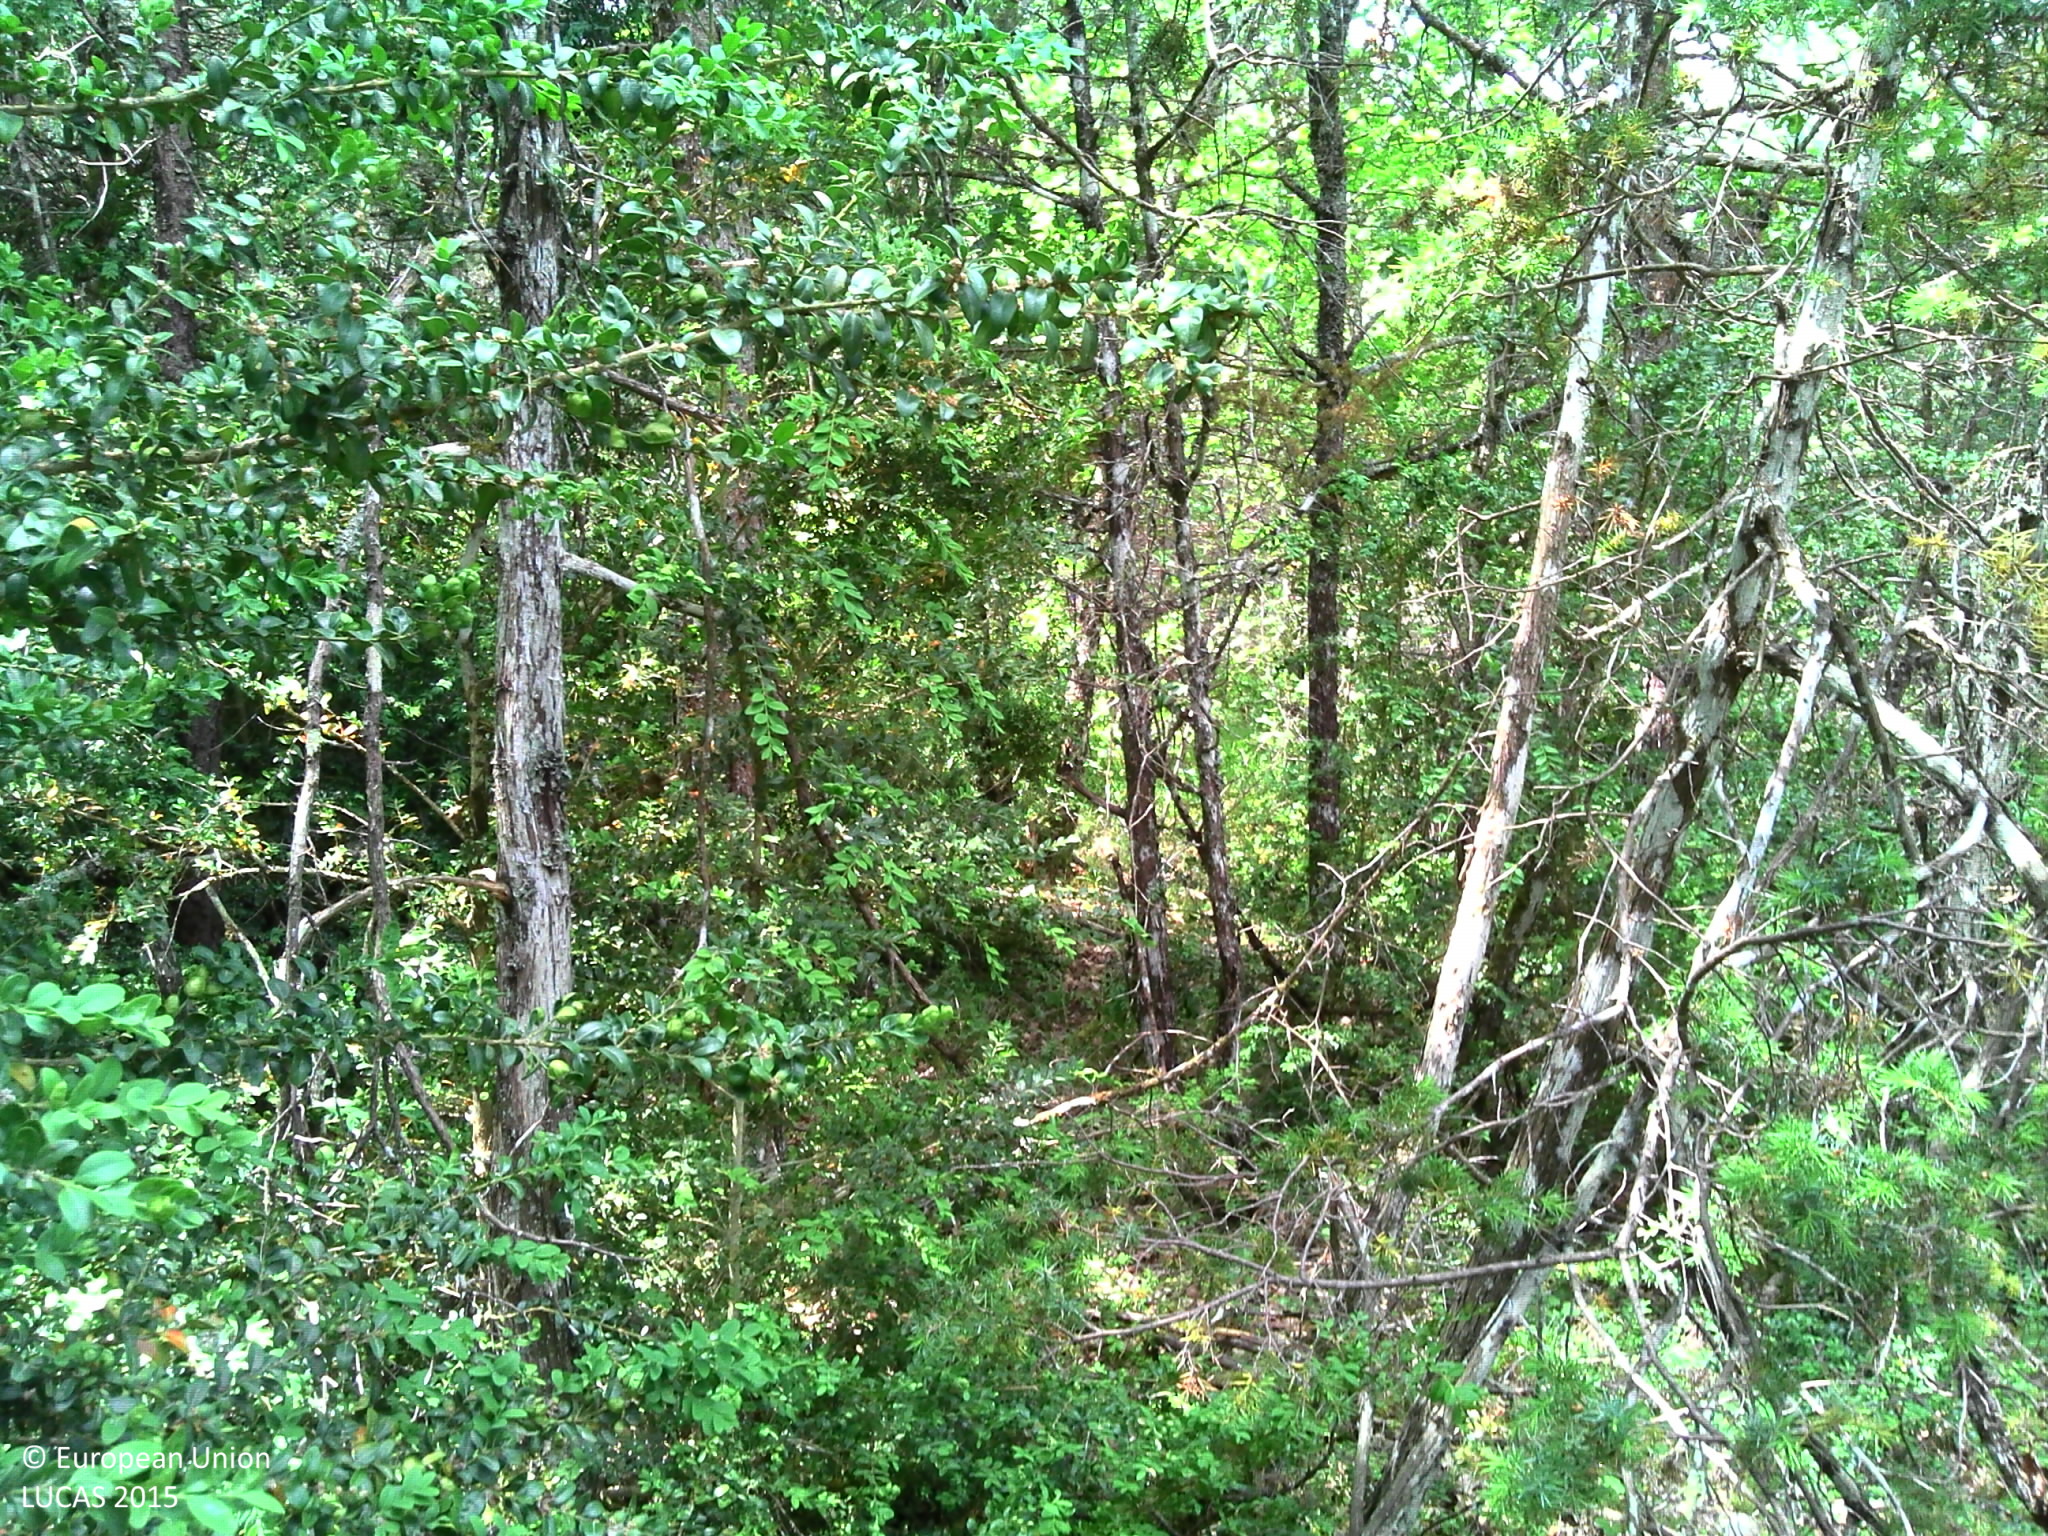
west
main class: Woodland
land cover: Pine dominated mixed woodland
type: mountainous beech forest
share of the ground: > 75 %
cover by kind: coniferous forest trees 35 %, broadleaved forest trees 35 %, herbaceous plants 20 %, lichens and mosses 10 %
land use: Forestry
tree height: > 5 m
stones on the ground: 25 - 50 %
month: June
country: FR
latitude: 44.1483
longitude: 3.2425
